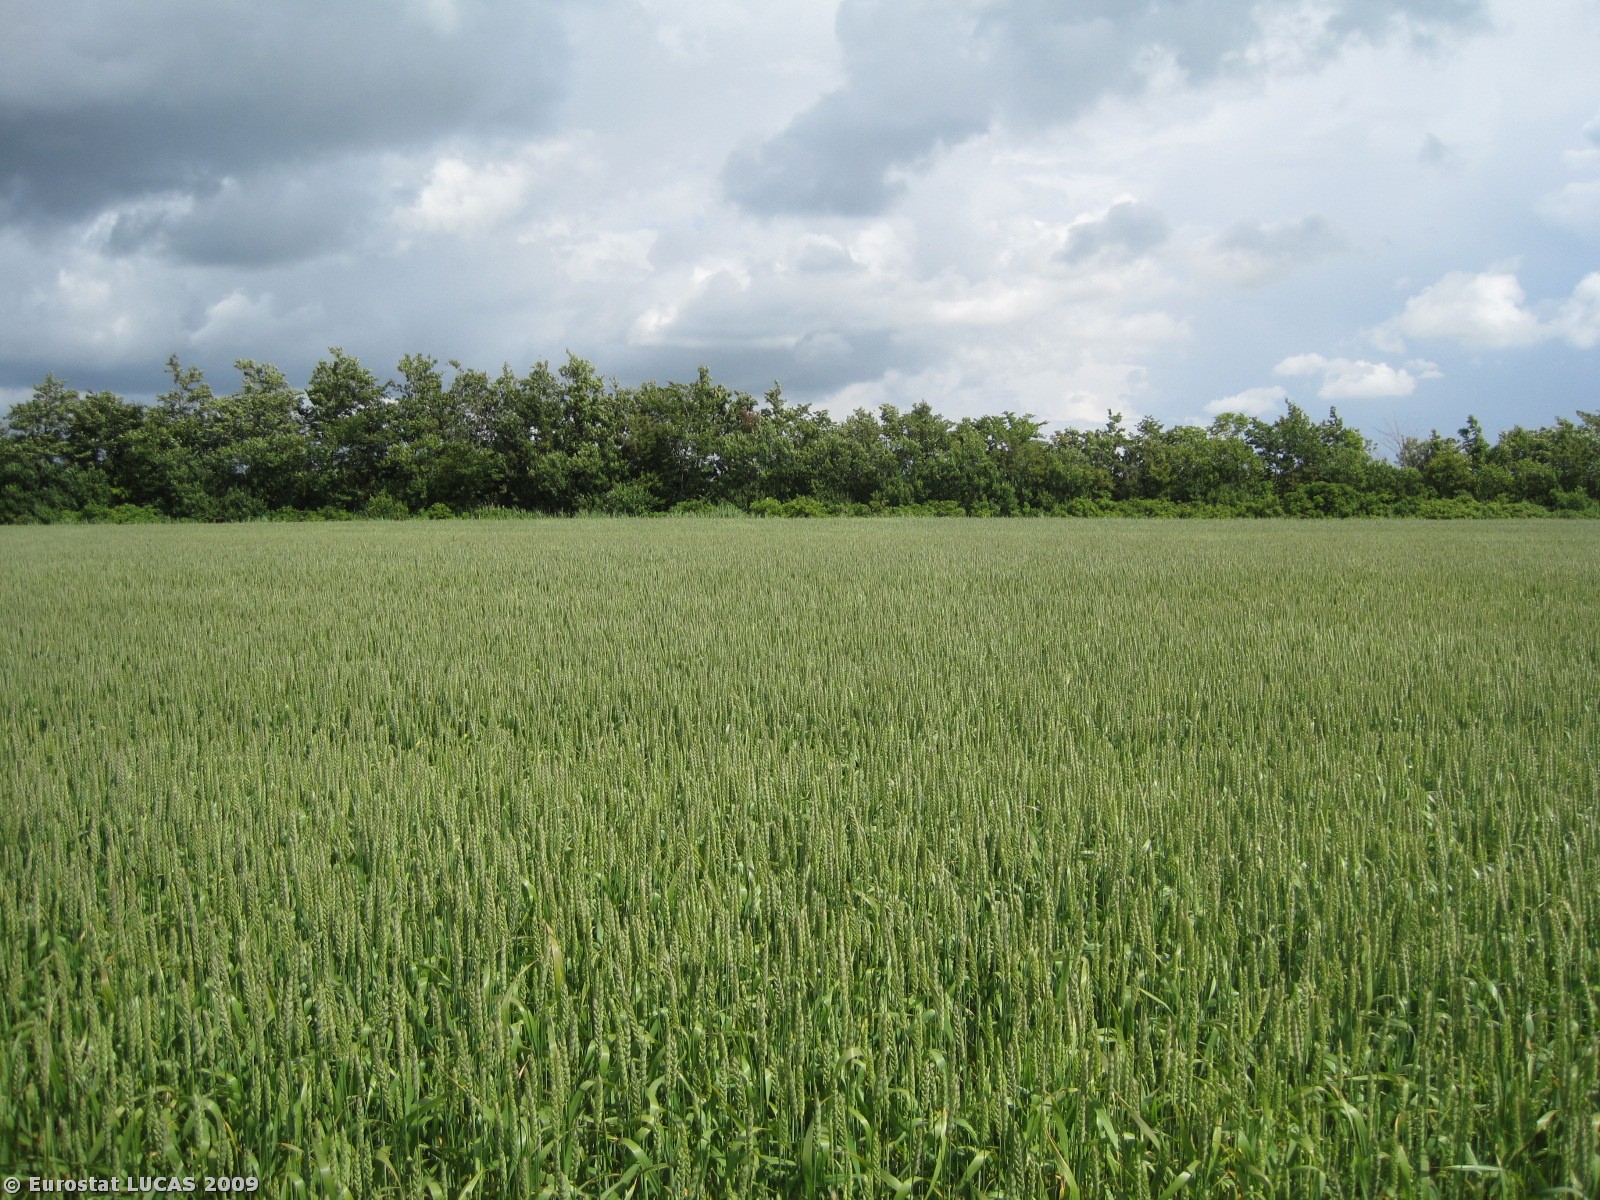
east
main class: Cropland
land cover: Common wheat
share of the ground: > 75 %
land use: Agriculture (excluding fallow land and kitchen gardens)
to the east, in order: Common wheat; Grass margins; Shrubland without tree cover; Broadleaved woodland; Grass margins; Common wheat; Grass margins; Broadleaved woodland; Grass margins; Rape and turnip rape
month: June
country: DK
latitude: 57.0661
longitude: 9.1931
